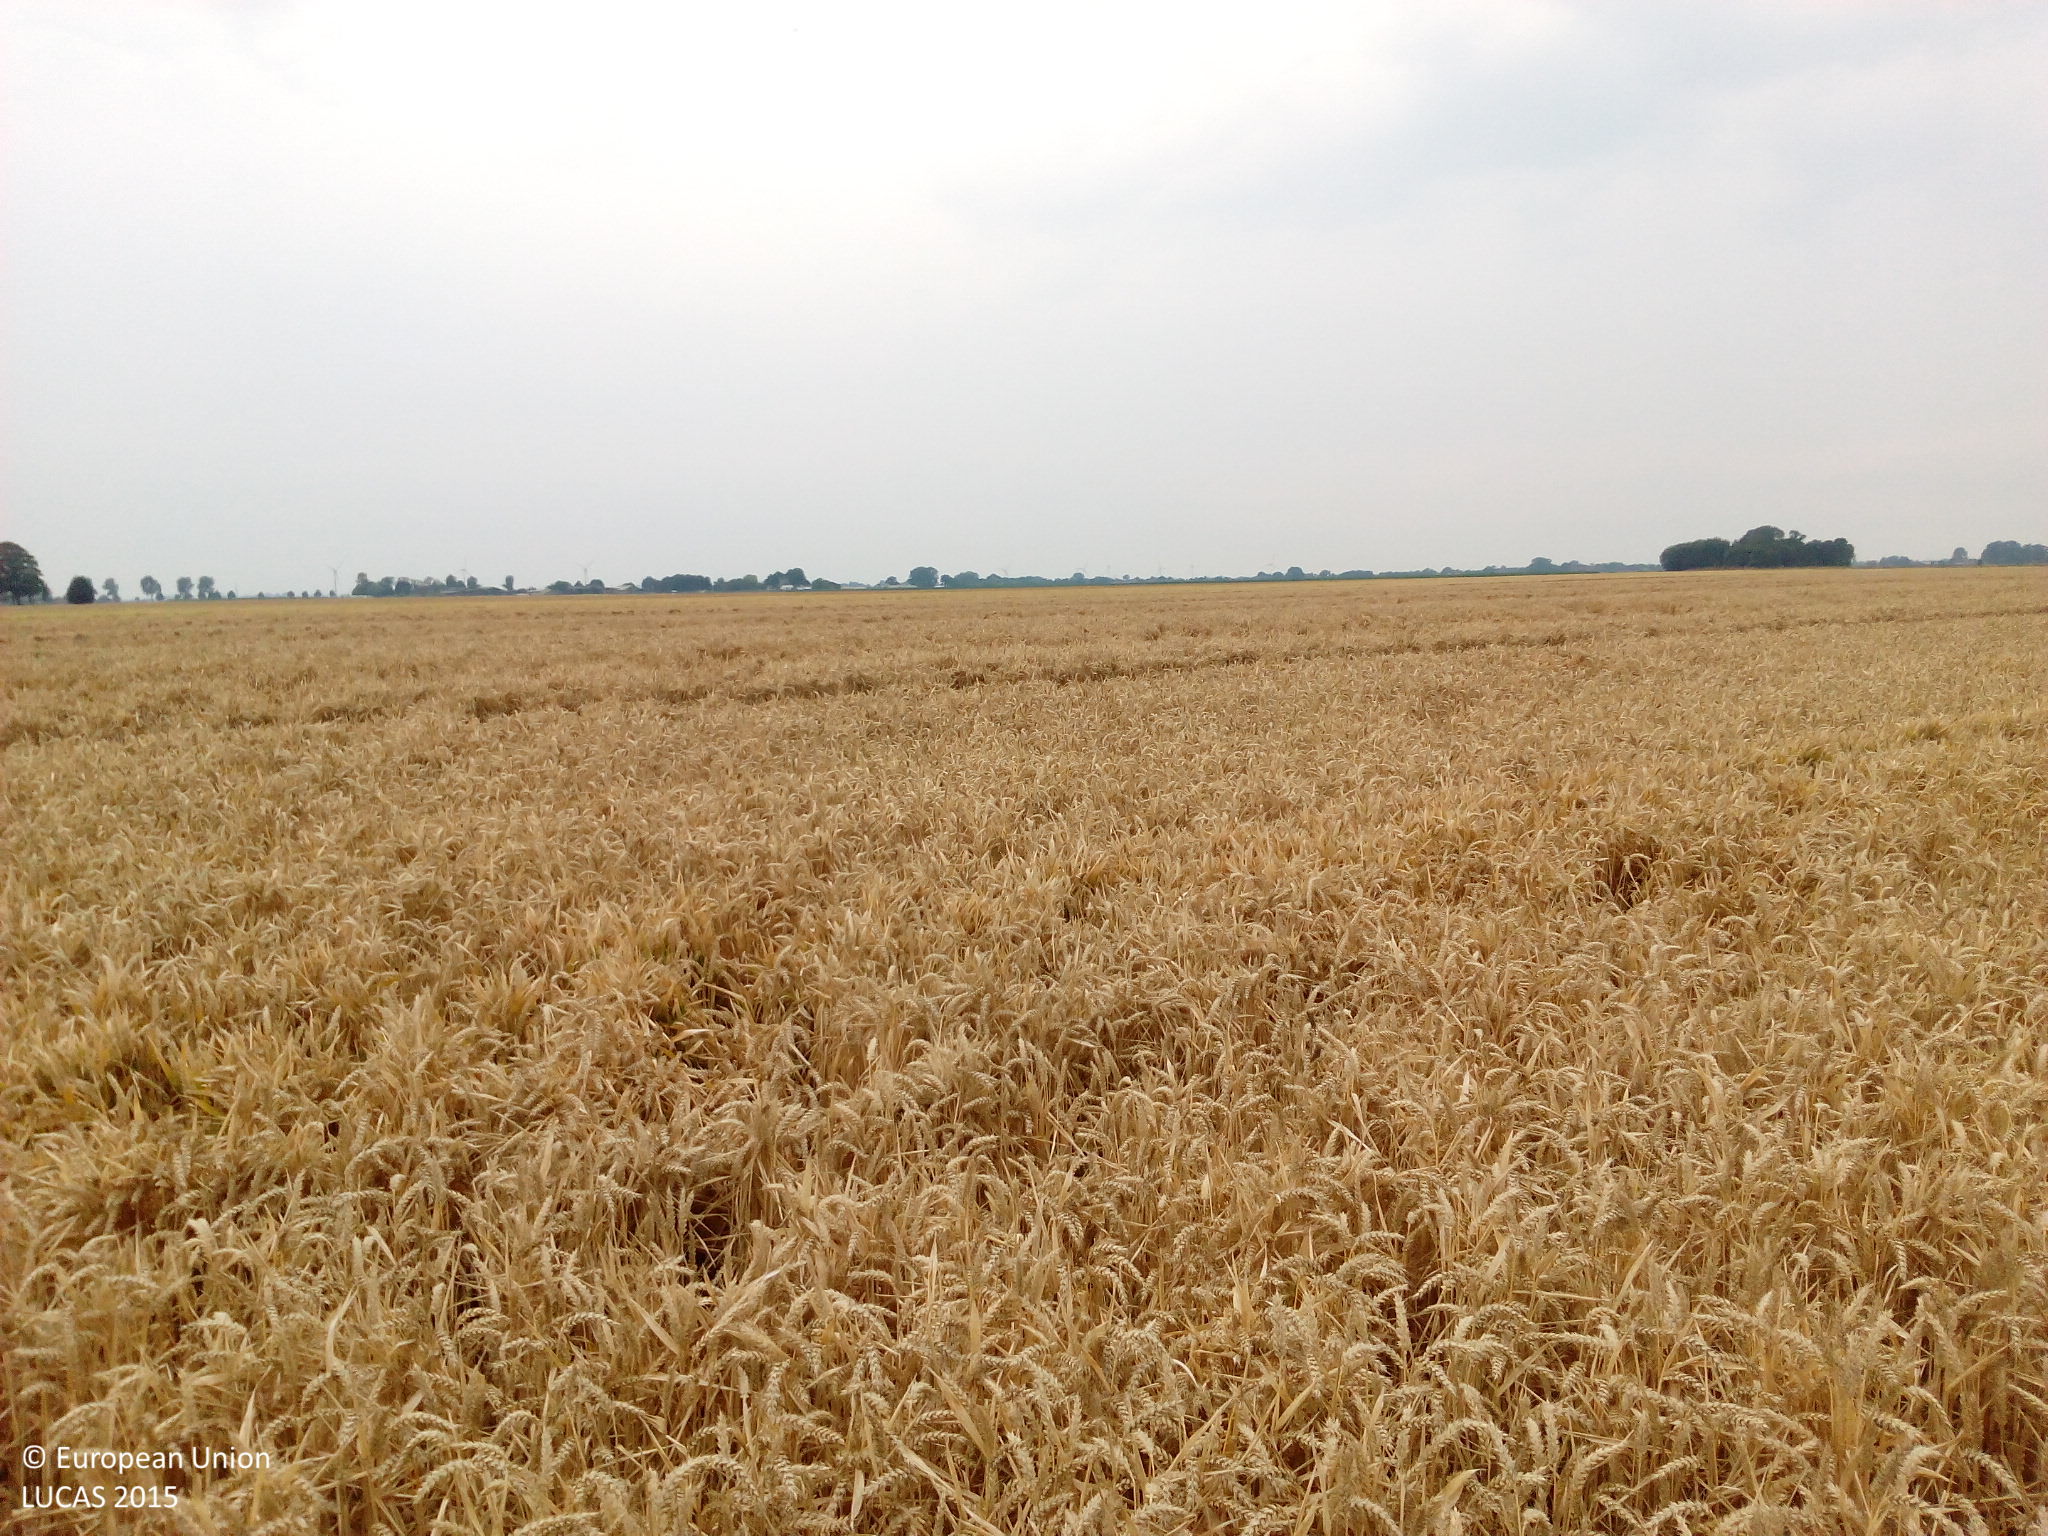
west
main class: Cropland
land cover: Common wheat
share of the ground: > 75 %
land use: Agriculture (excluding fallow land and kitchen gardens)
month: August
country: DE
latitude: 53.8145
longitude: 9.5598
